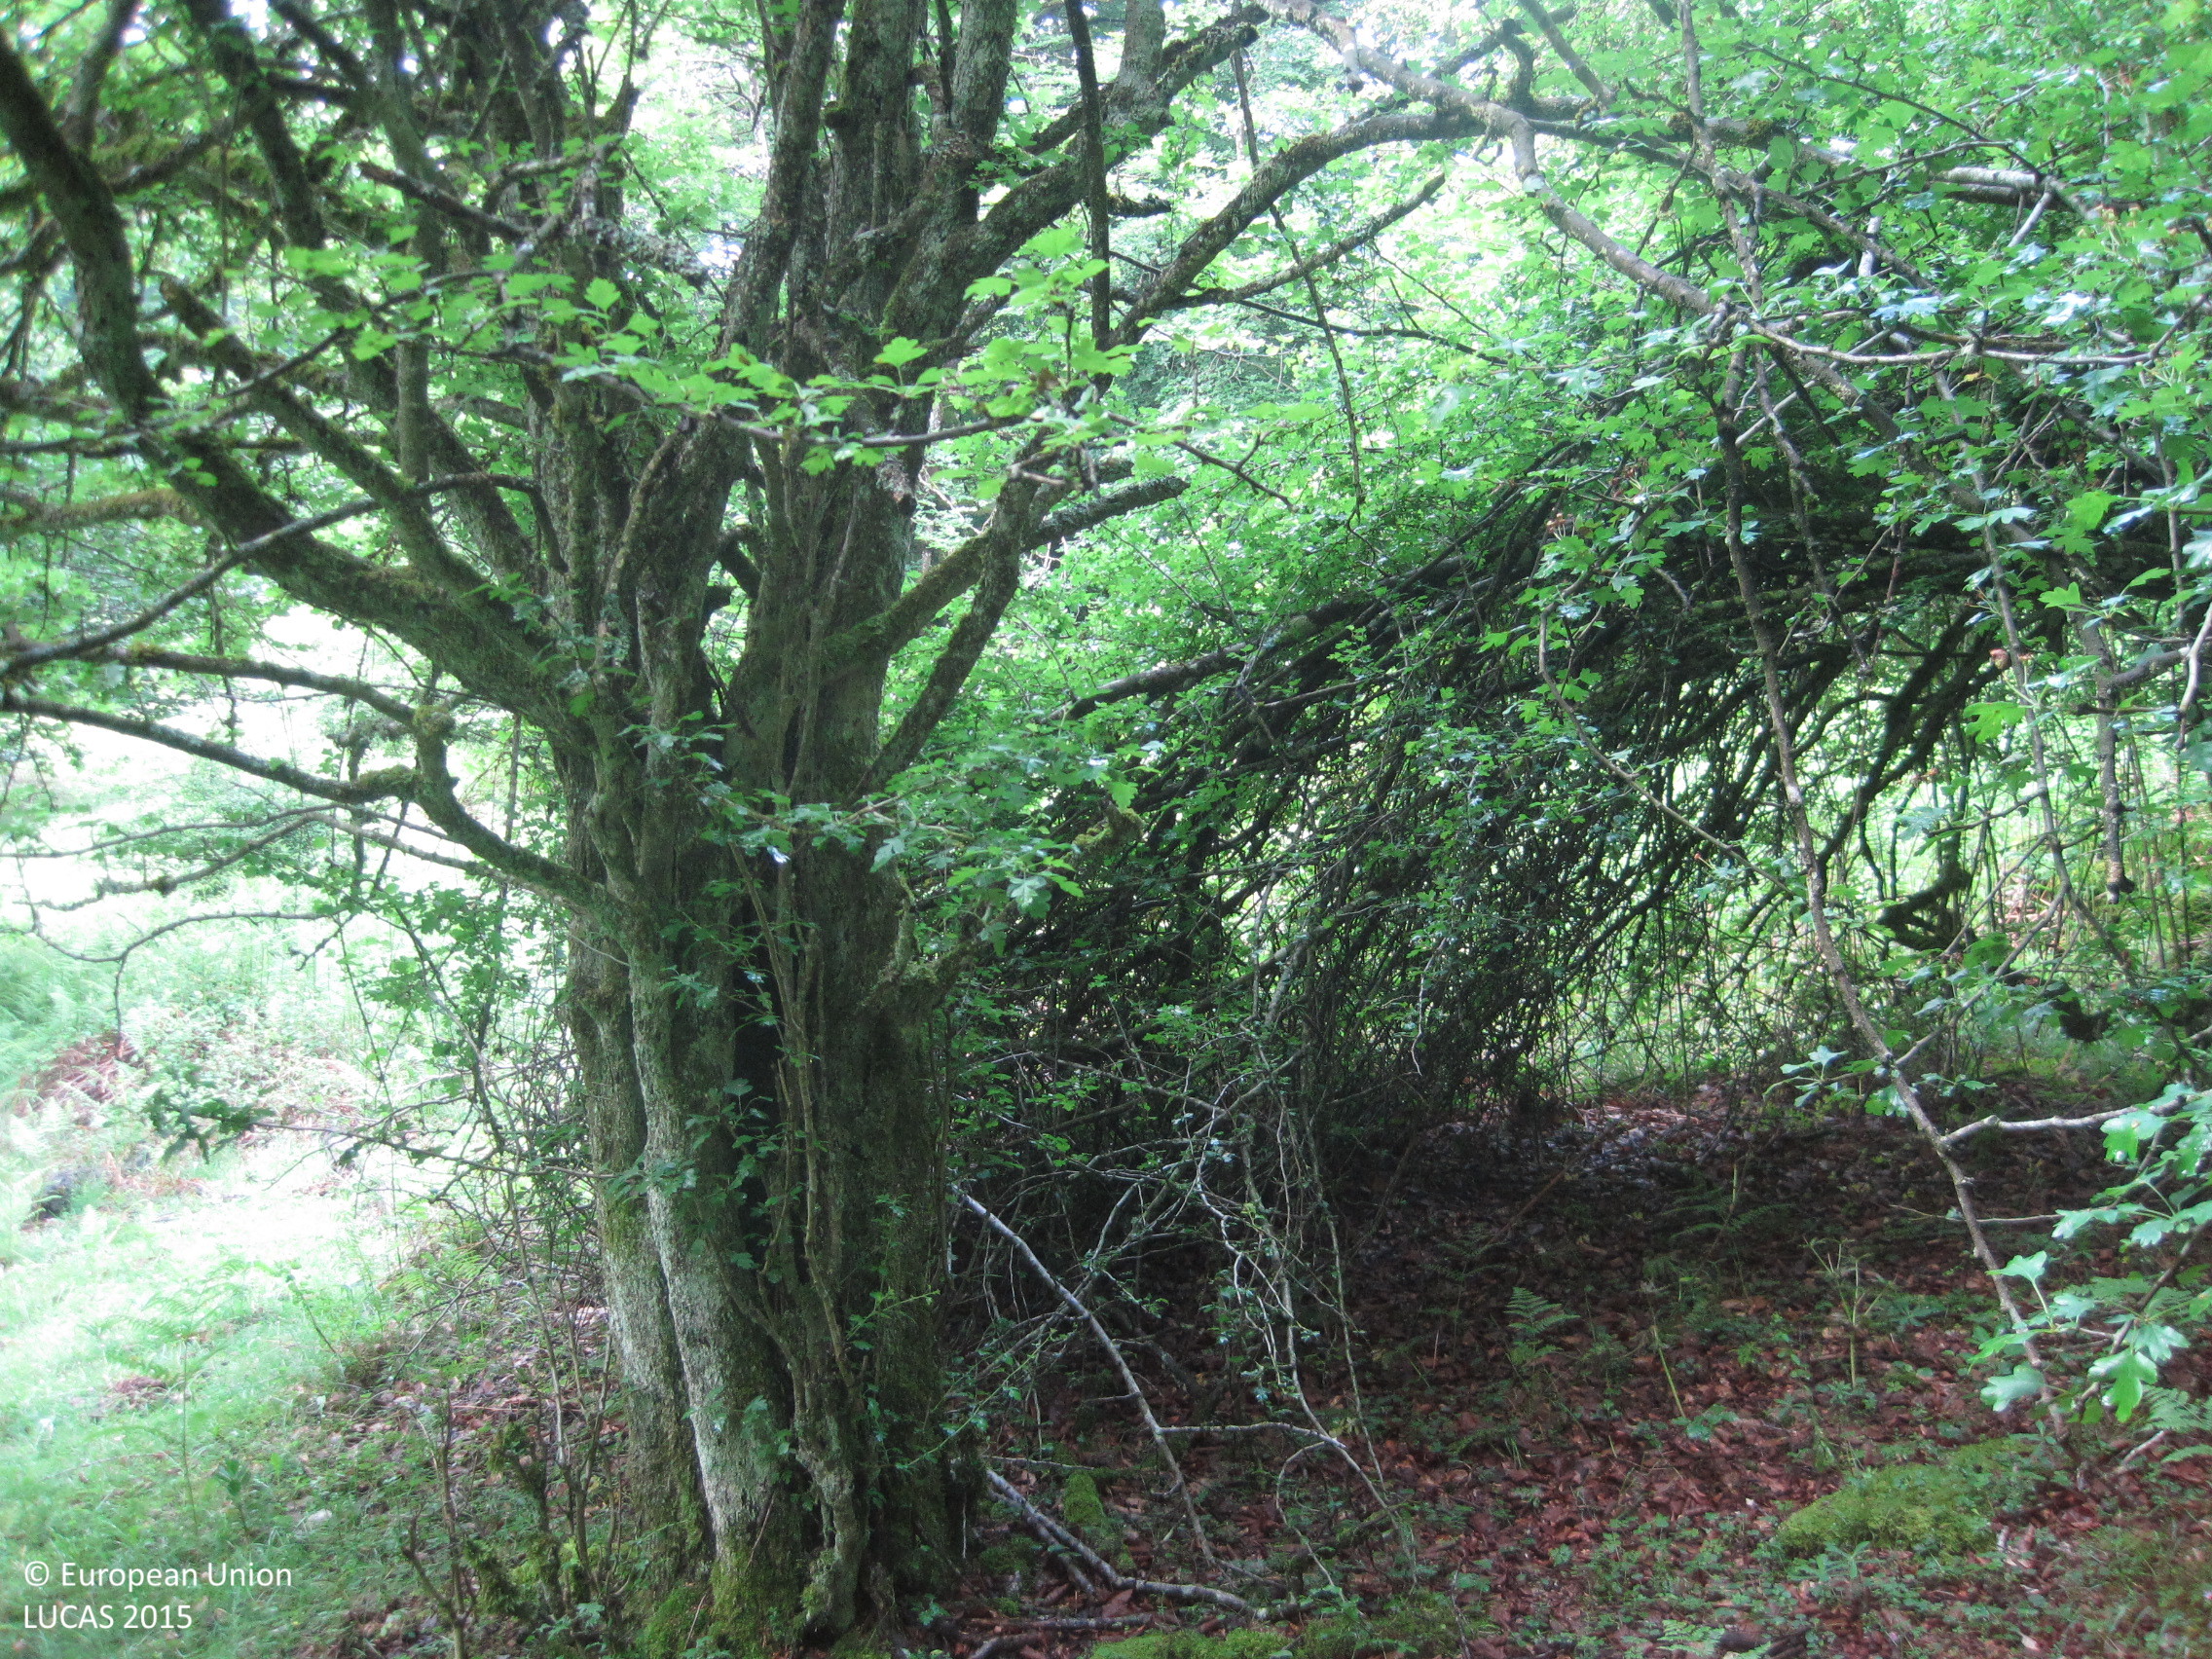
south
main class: Woodland
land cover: Broadleaved woodland
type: beech forest
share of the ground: > 75 %
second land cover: Grassland without tree/shrub cover
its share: > 75 %
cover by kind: broadleaved forest trees 80 %, herbaceous plants 20 %
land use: Forestry
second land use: Agriculture (excluding fallow land and kitchen gardens)
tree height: > 5 m
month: June
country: ES
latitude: 42.8444
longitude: -2.1957
